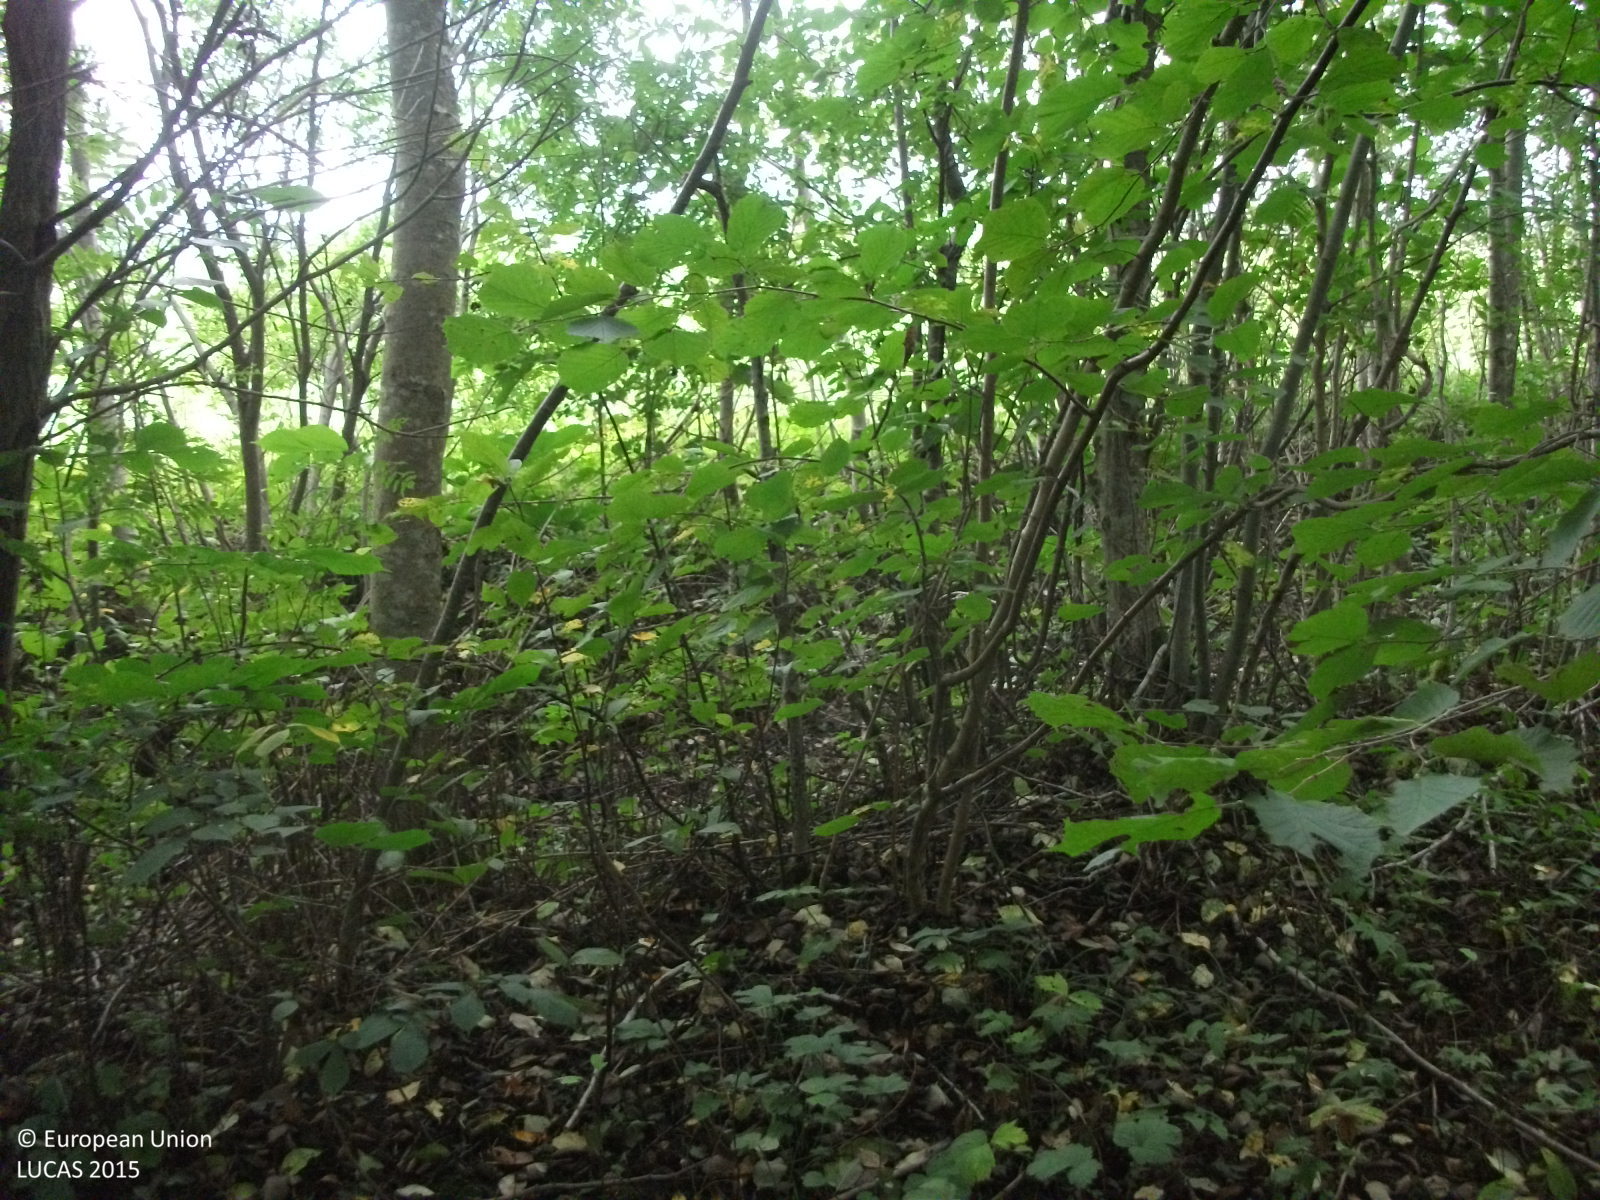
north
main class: Woodland
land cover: Broadleaved woodland
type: non-riverine alder, birch or aspen forest
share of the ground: > 75 %
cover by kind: broadleaved forest trees 80 %, herbaceous plants 10 %, shrubs 5 %, unconsolidated bare surface 5 %
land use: Forestry
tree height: > 5 m
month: September
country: LV
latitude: 57.4618
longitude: 24.6814
